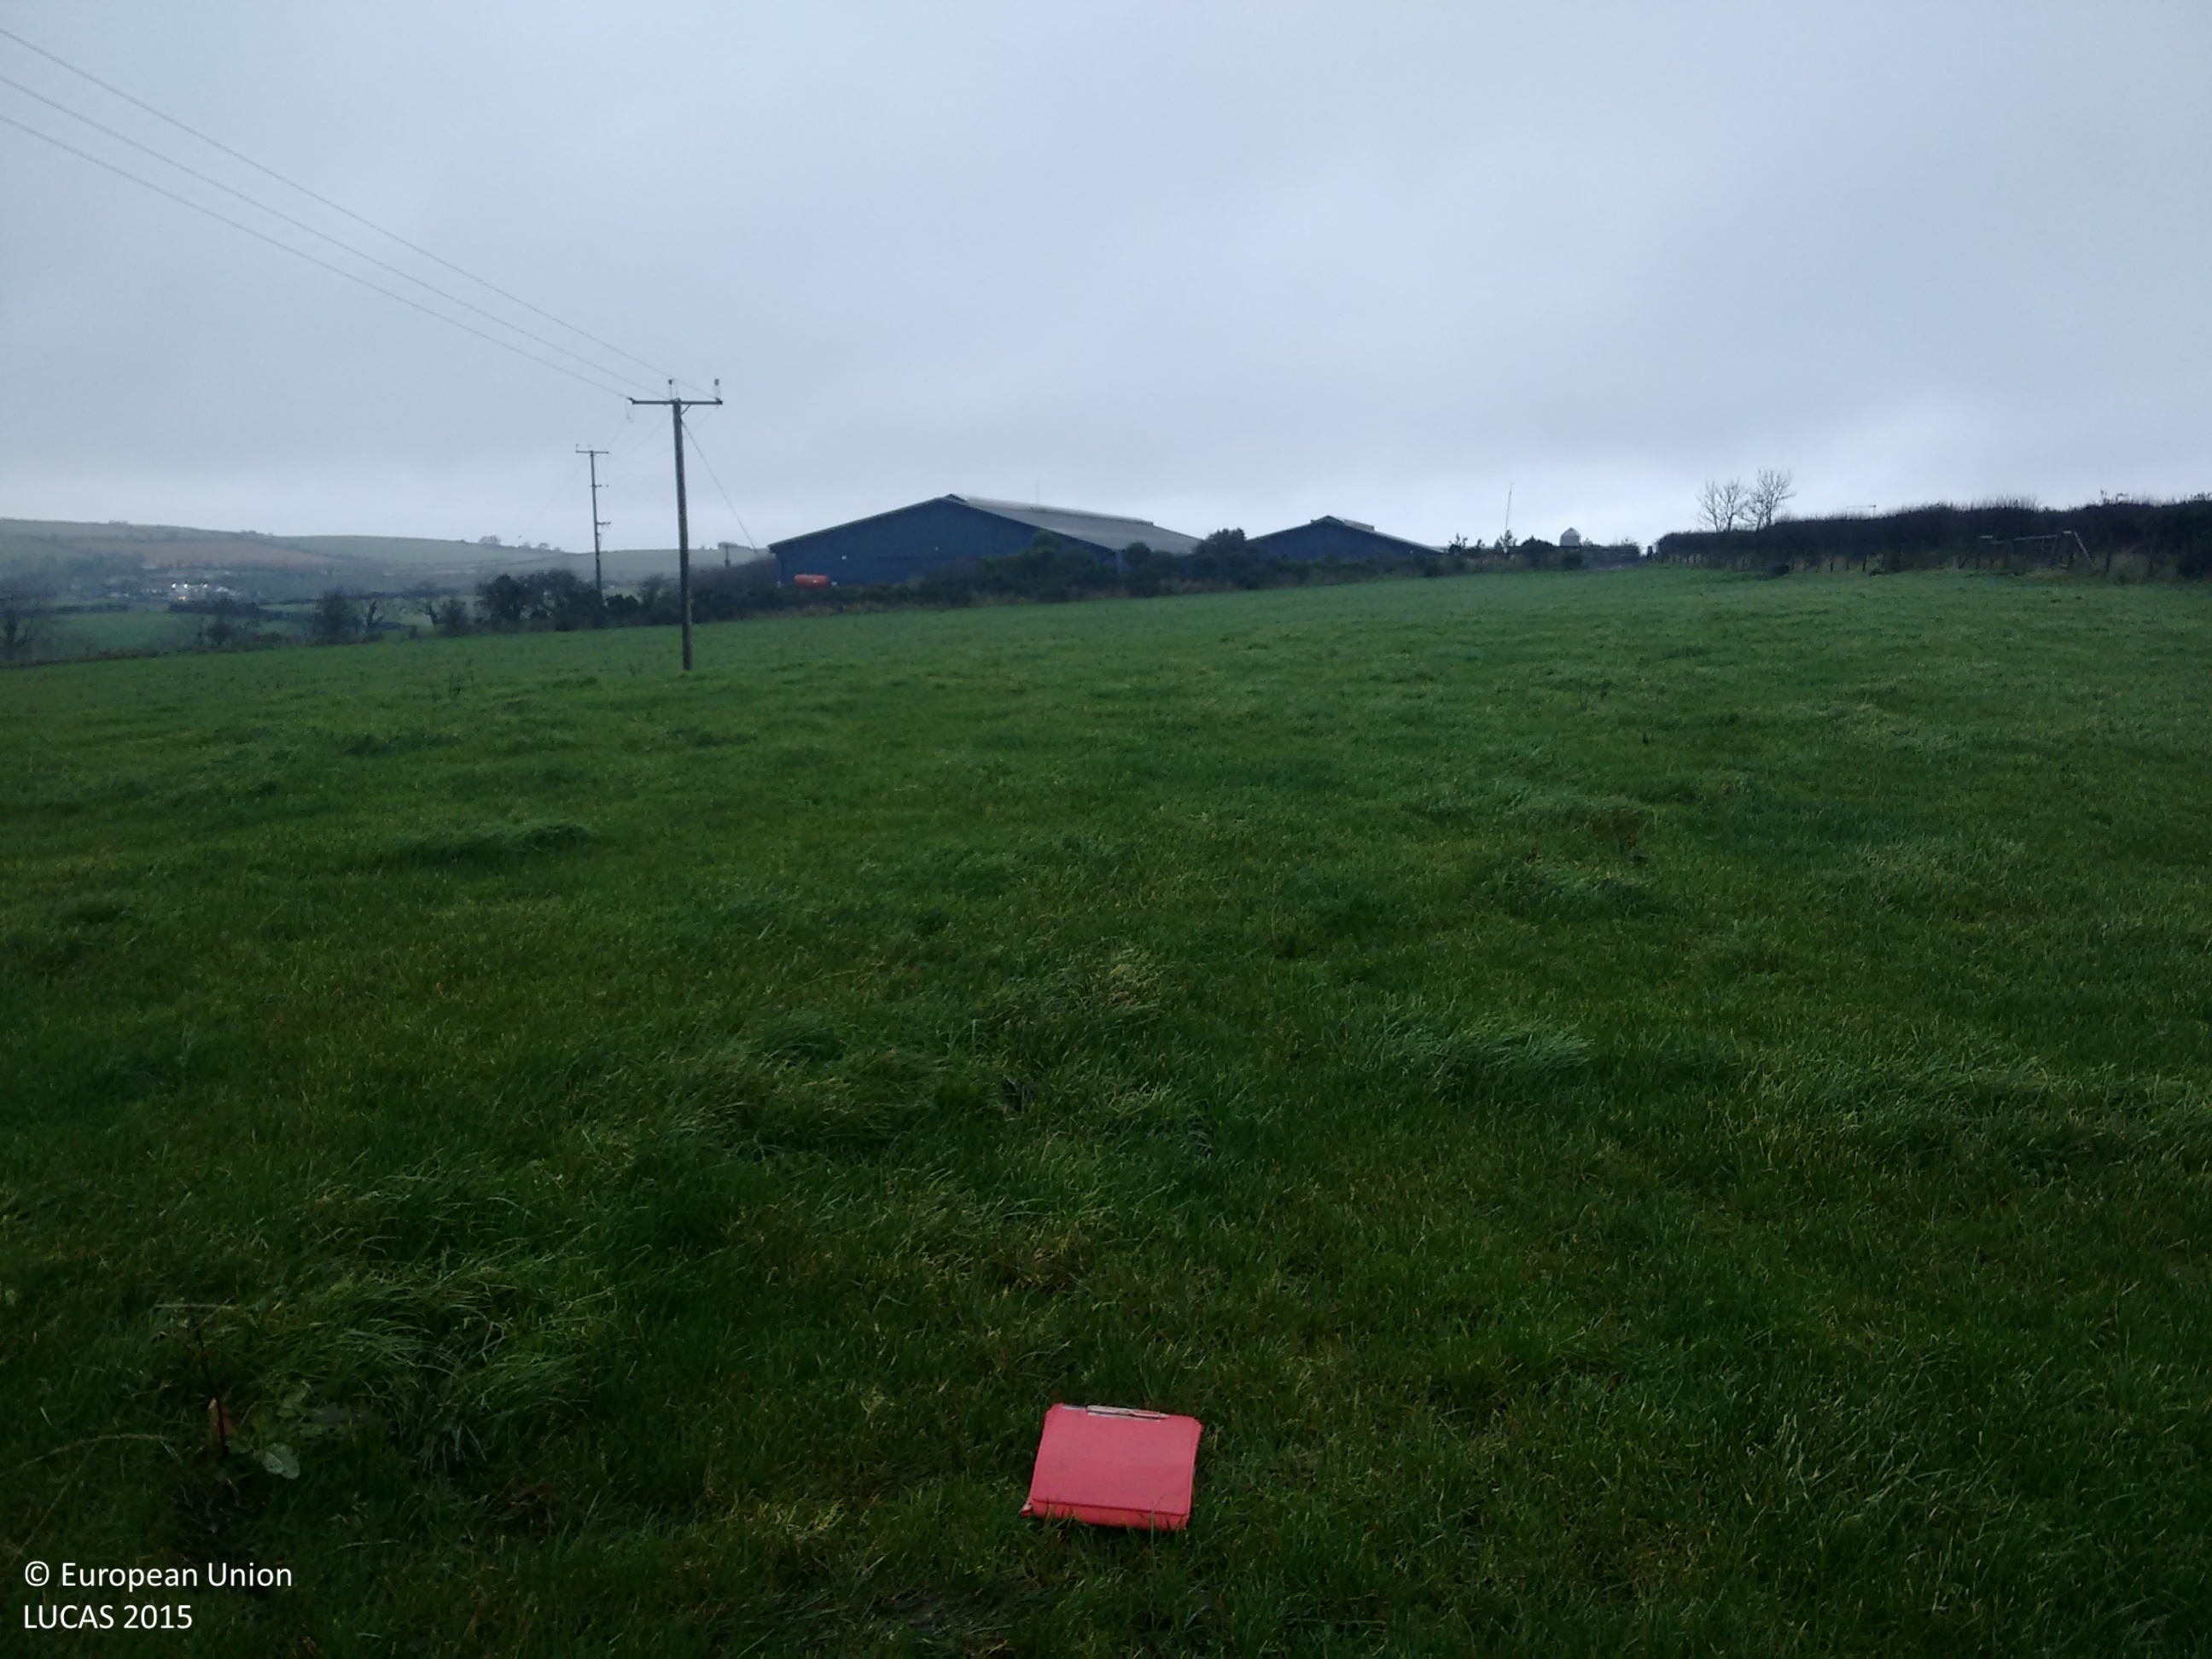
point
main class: Grassland
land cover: Grassland without tree/shrub cover
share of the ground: > 75 %
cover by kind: herbaceous plants 100 %
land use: Agriculture (excluding fallow land and kitchen gardens)
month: November
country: GB
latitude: 54.6134
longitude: -5.7894
